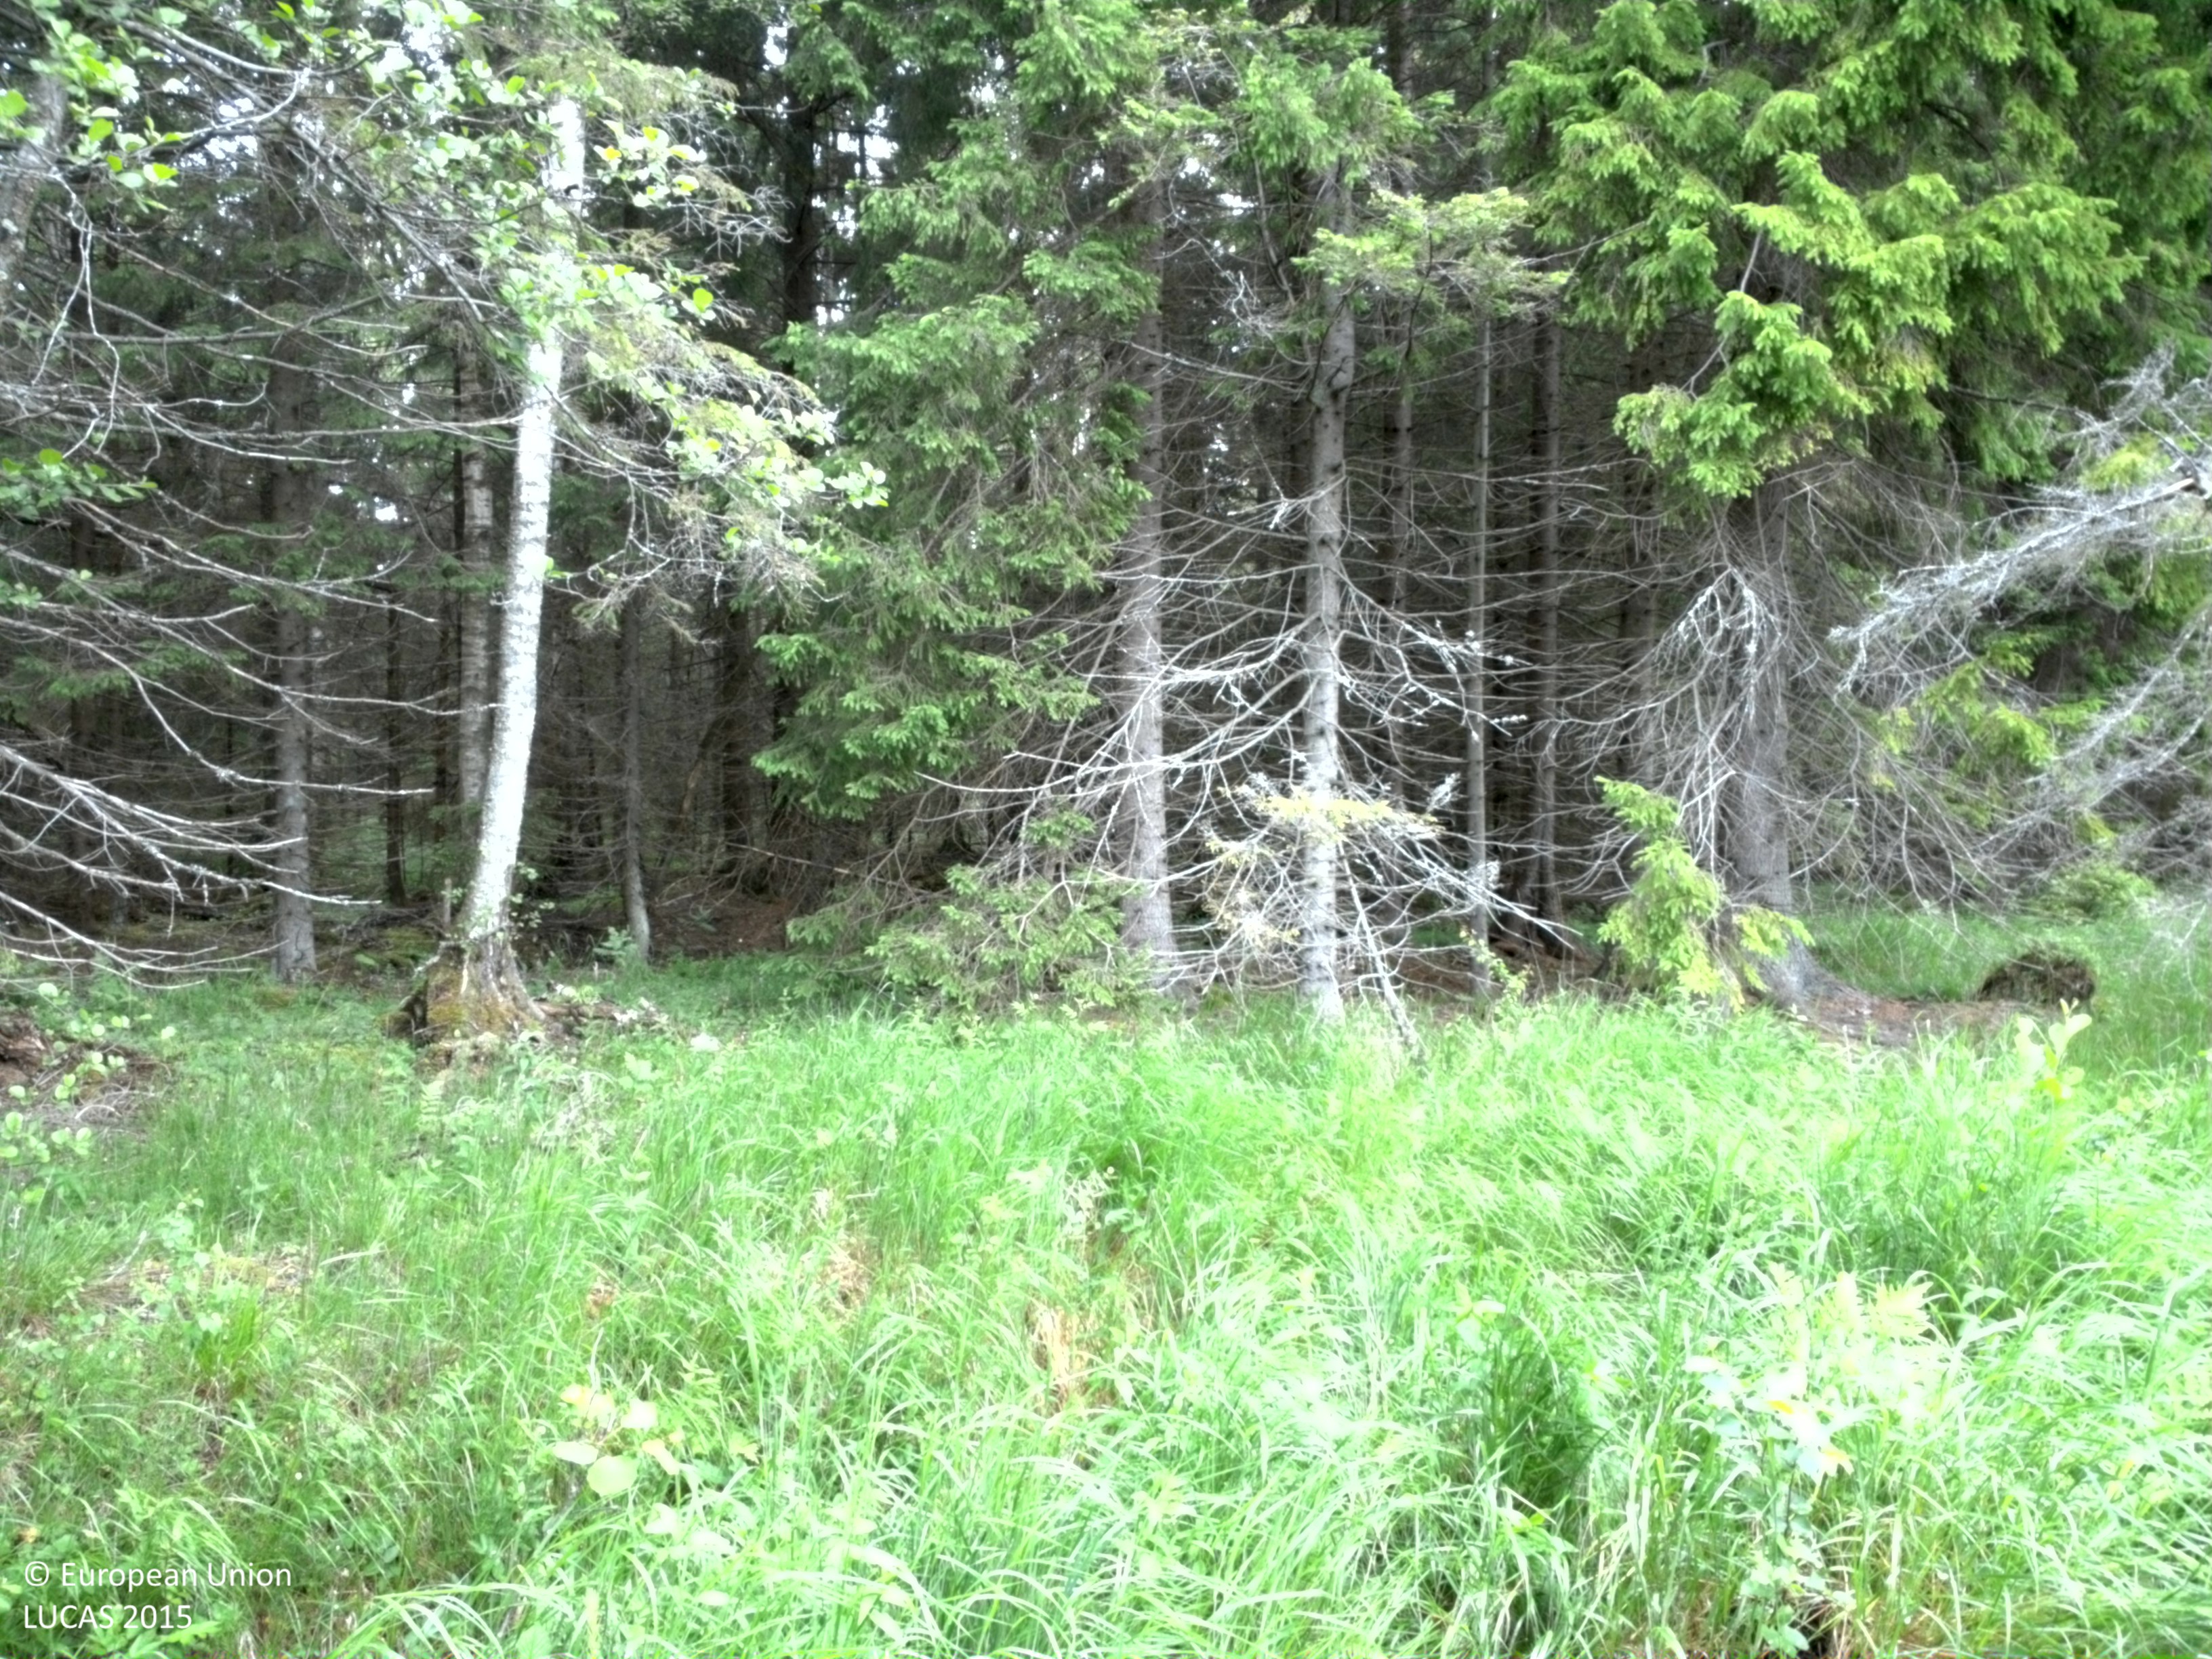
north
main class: Shrubland
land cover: Shrubland with sparse tree cover
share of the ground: 25 - 50 %
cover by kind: shrubs 40 %, herbaceous plants 30 %, lichens and mosses 25 %, coniferous forest trees 5 %
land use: Forestry
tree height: < 5 m
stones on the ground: < 10 %
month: June
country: SE
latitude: 59.7149
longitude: 18.6576
